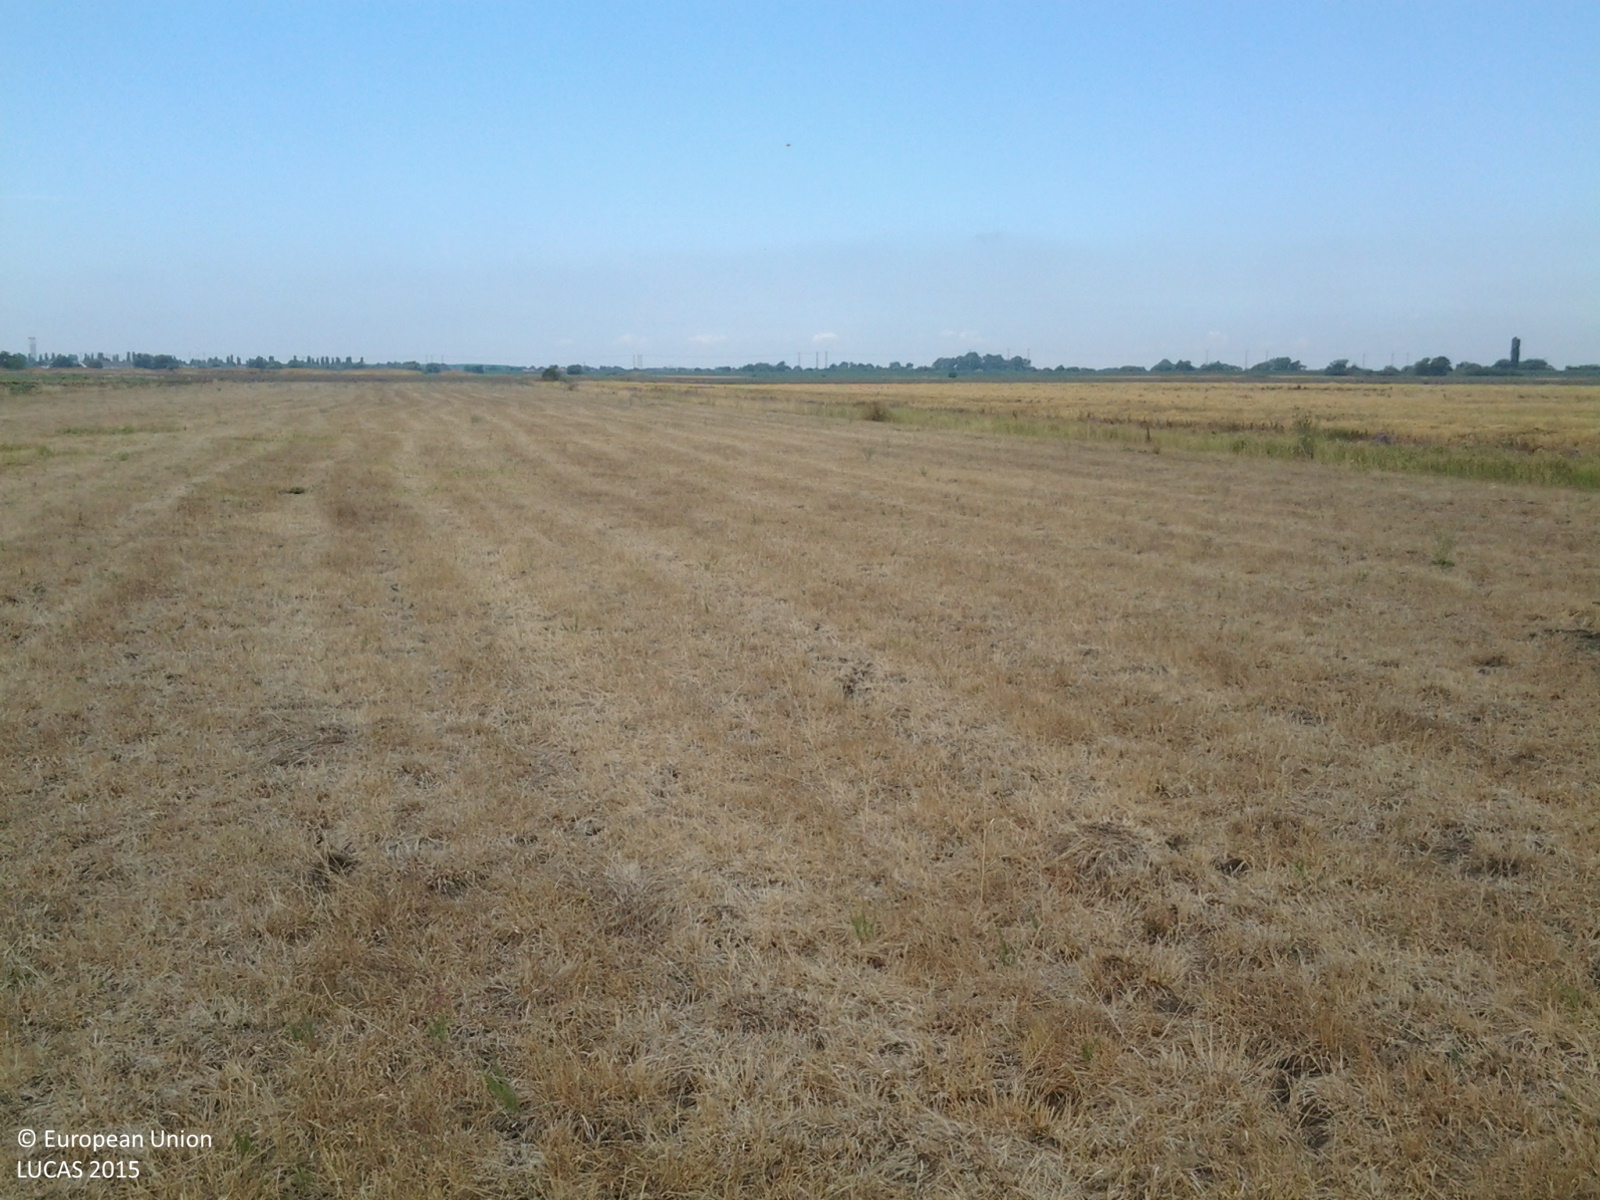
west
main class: Grassland
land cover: Grassland without tree/shrub cover
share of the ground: > 75 %
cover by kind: herbaceous plants 100 %
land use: Agriculture (excluding fallow land and kitchen gardens)
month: August
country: HU
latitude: 47.0322
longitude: 21.2090
